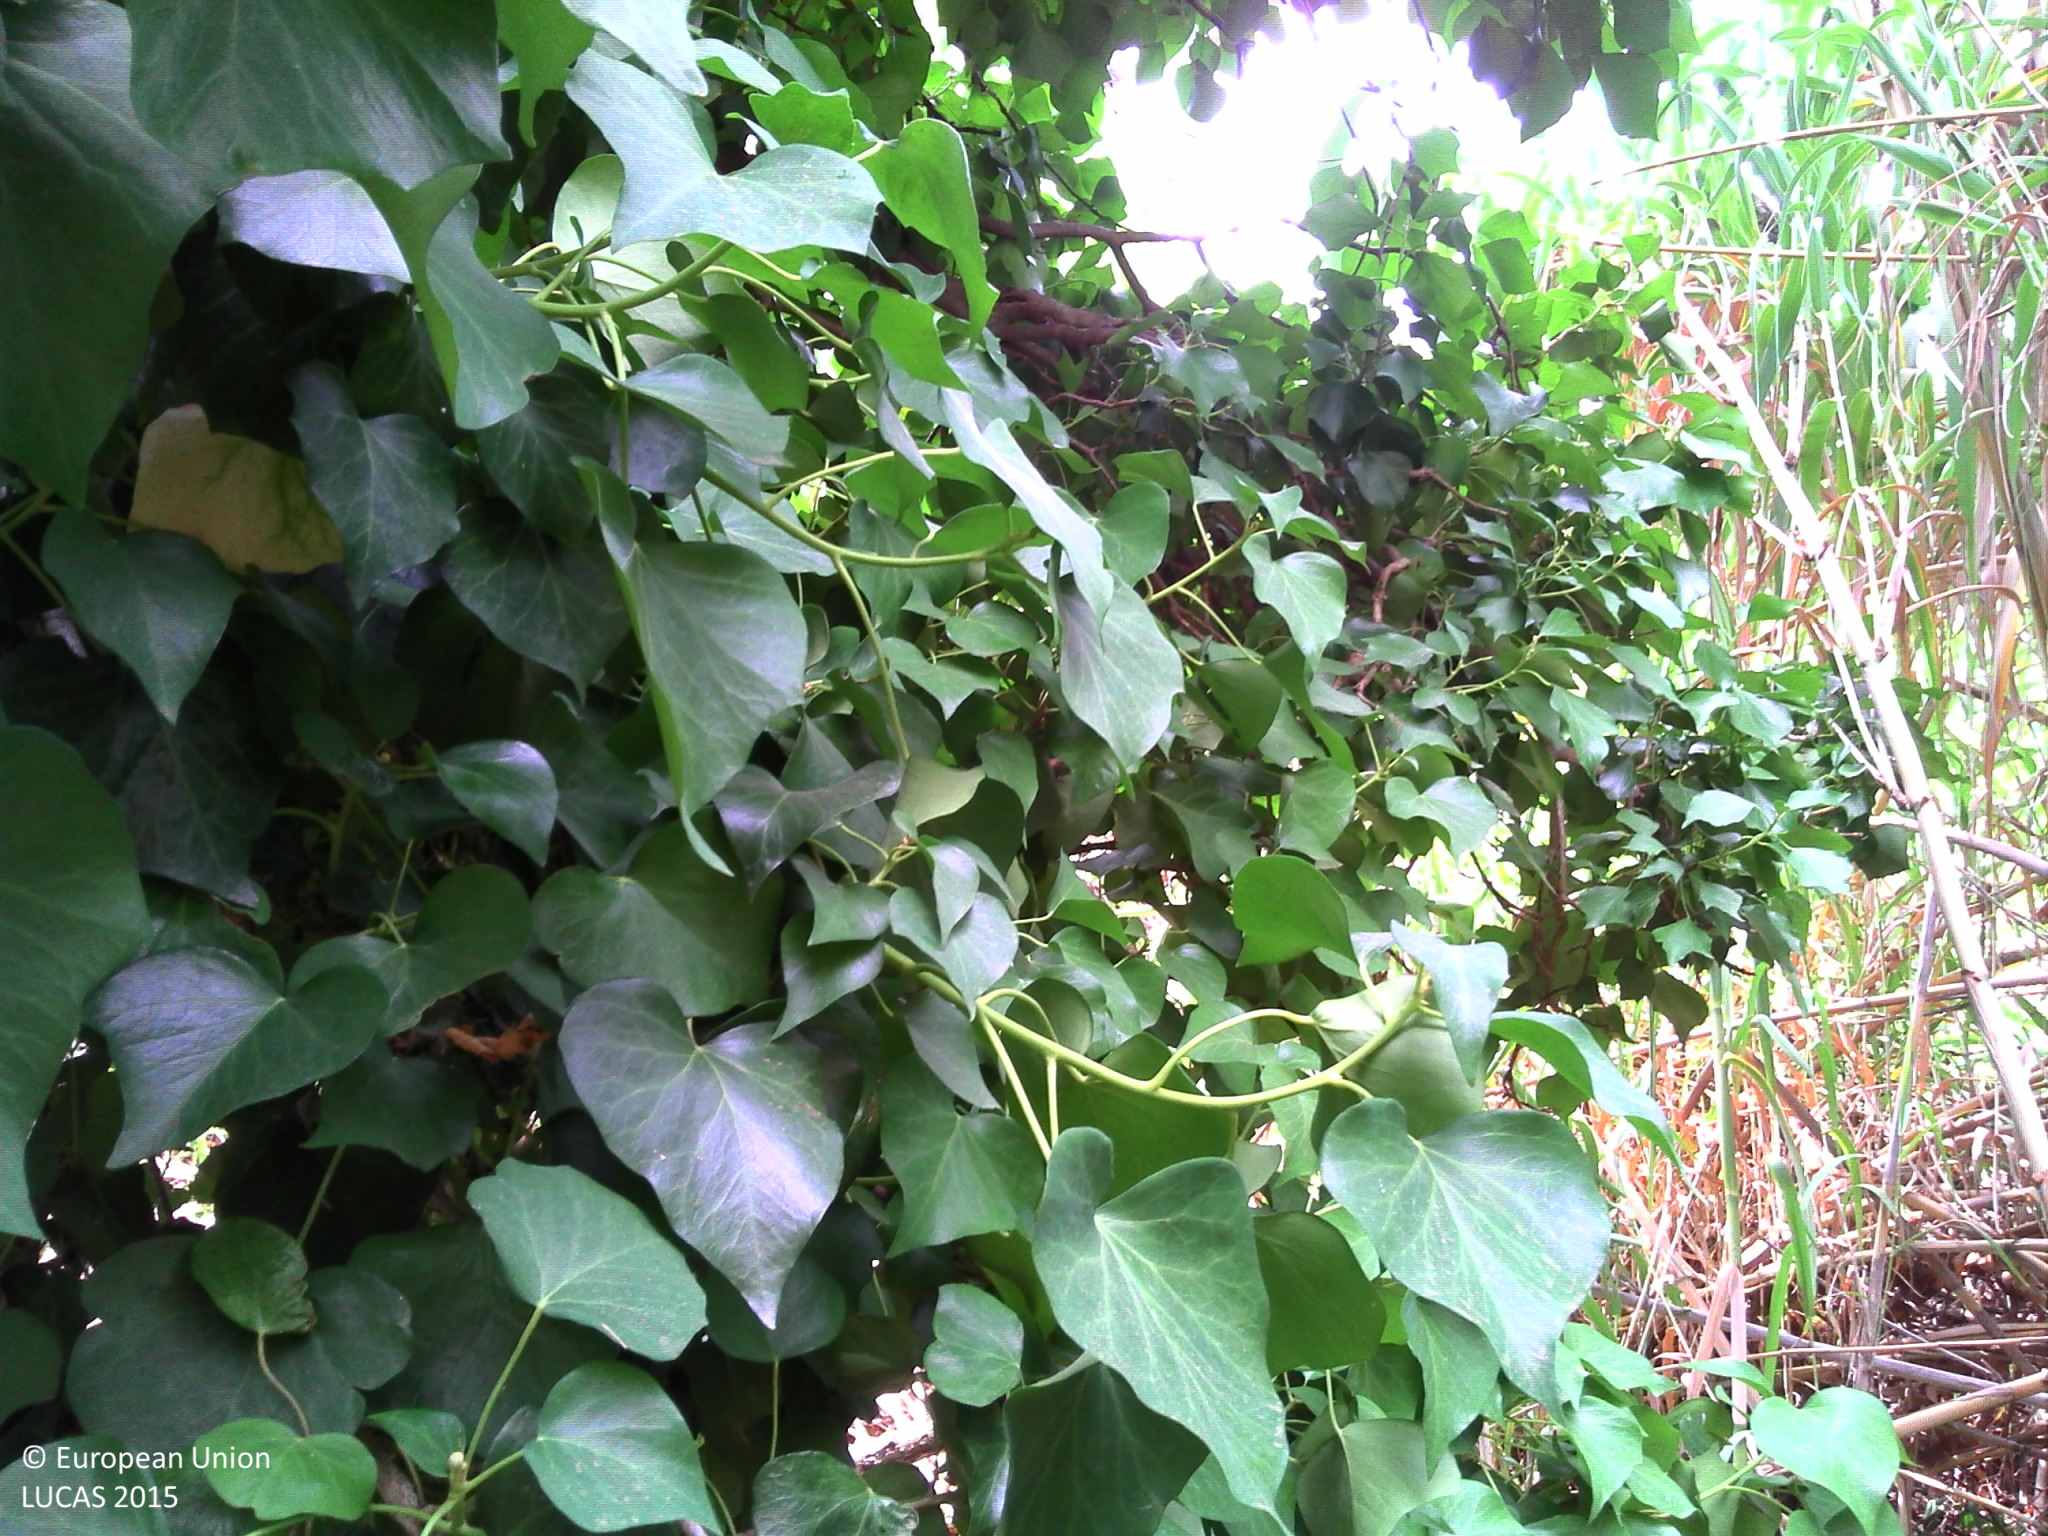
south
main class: Woodland
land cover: Broadleaved woodland
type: mesophytic deciduous forest
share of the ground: > 75 %
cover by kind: broadleaved forest trees 90 %, shrubs 10 %
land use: Semi-natural and natural areas not in use
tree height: > 5 m
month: July
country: FR
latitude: 42.6857
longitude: 2.7744
